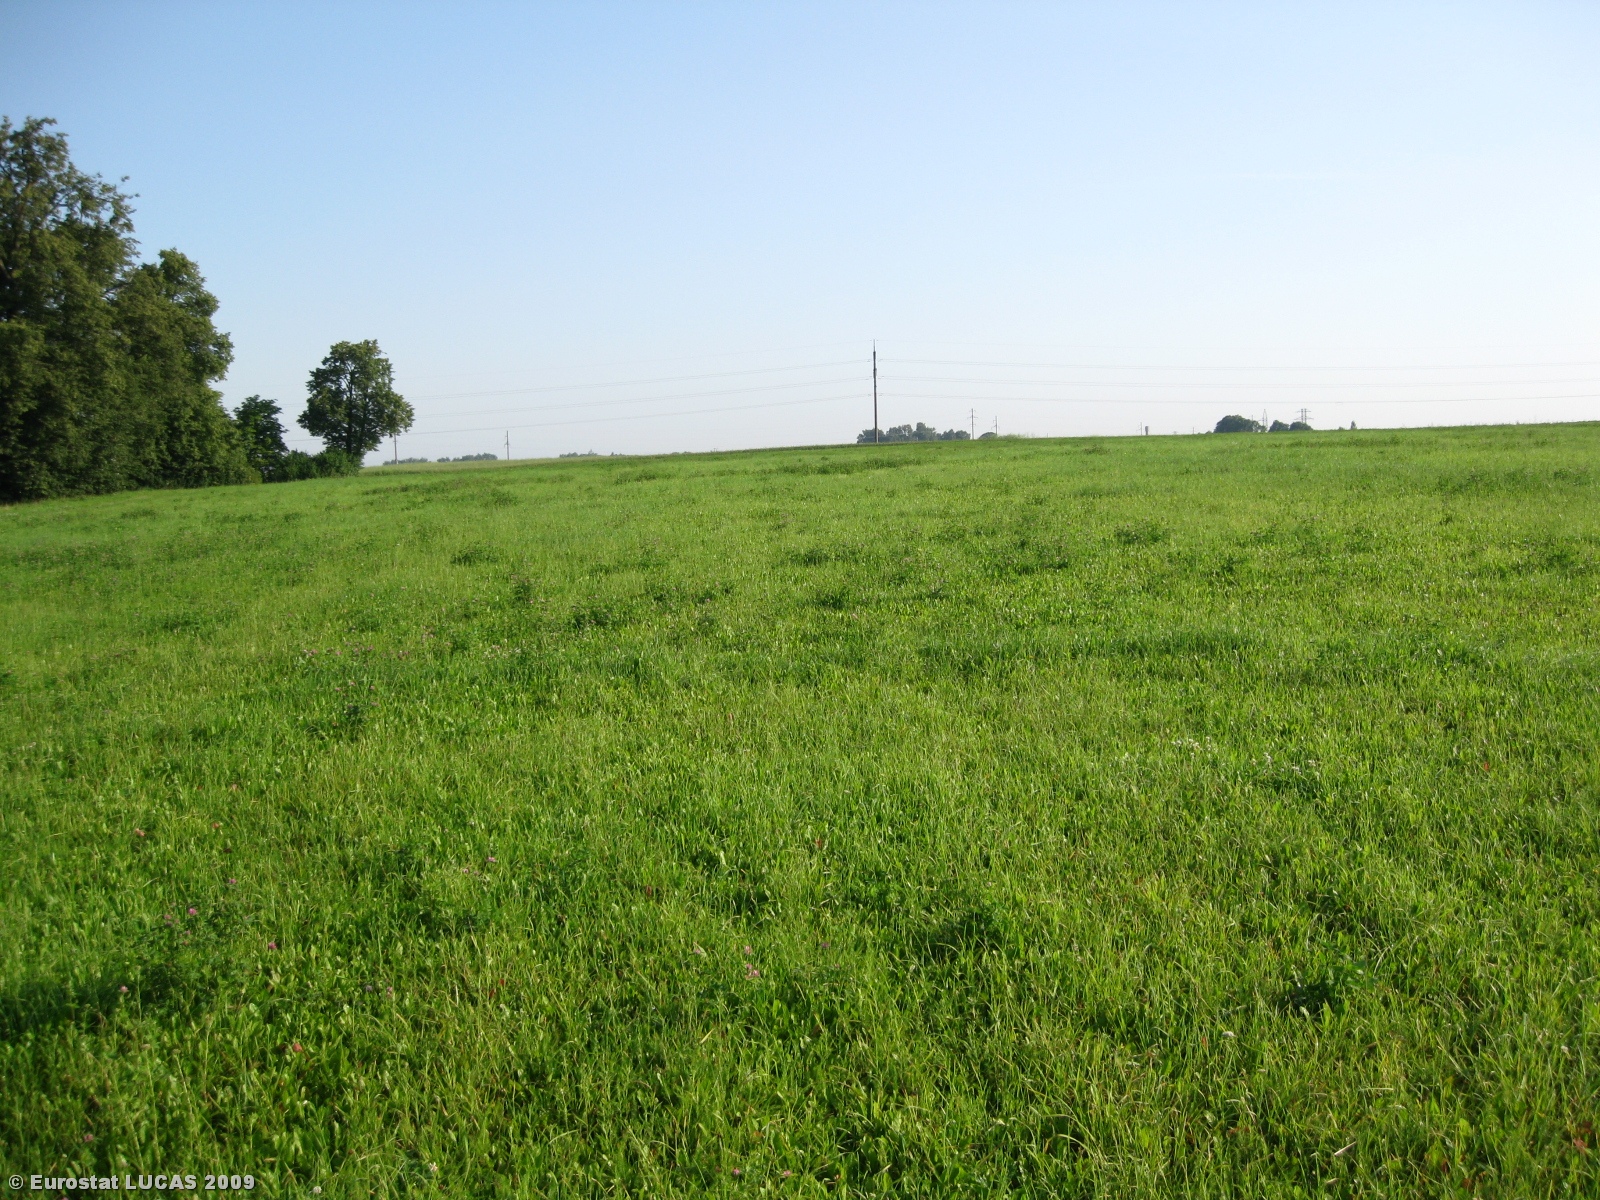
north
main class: Grassland
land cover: Grassland without tree/shrub cover
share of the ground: > 75 %
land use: Agriculture (excluding fallow land and kitchen gardens)
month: July
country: LT
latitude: 54.5651
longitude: 23.4275
